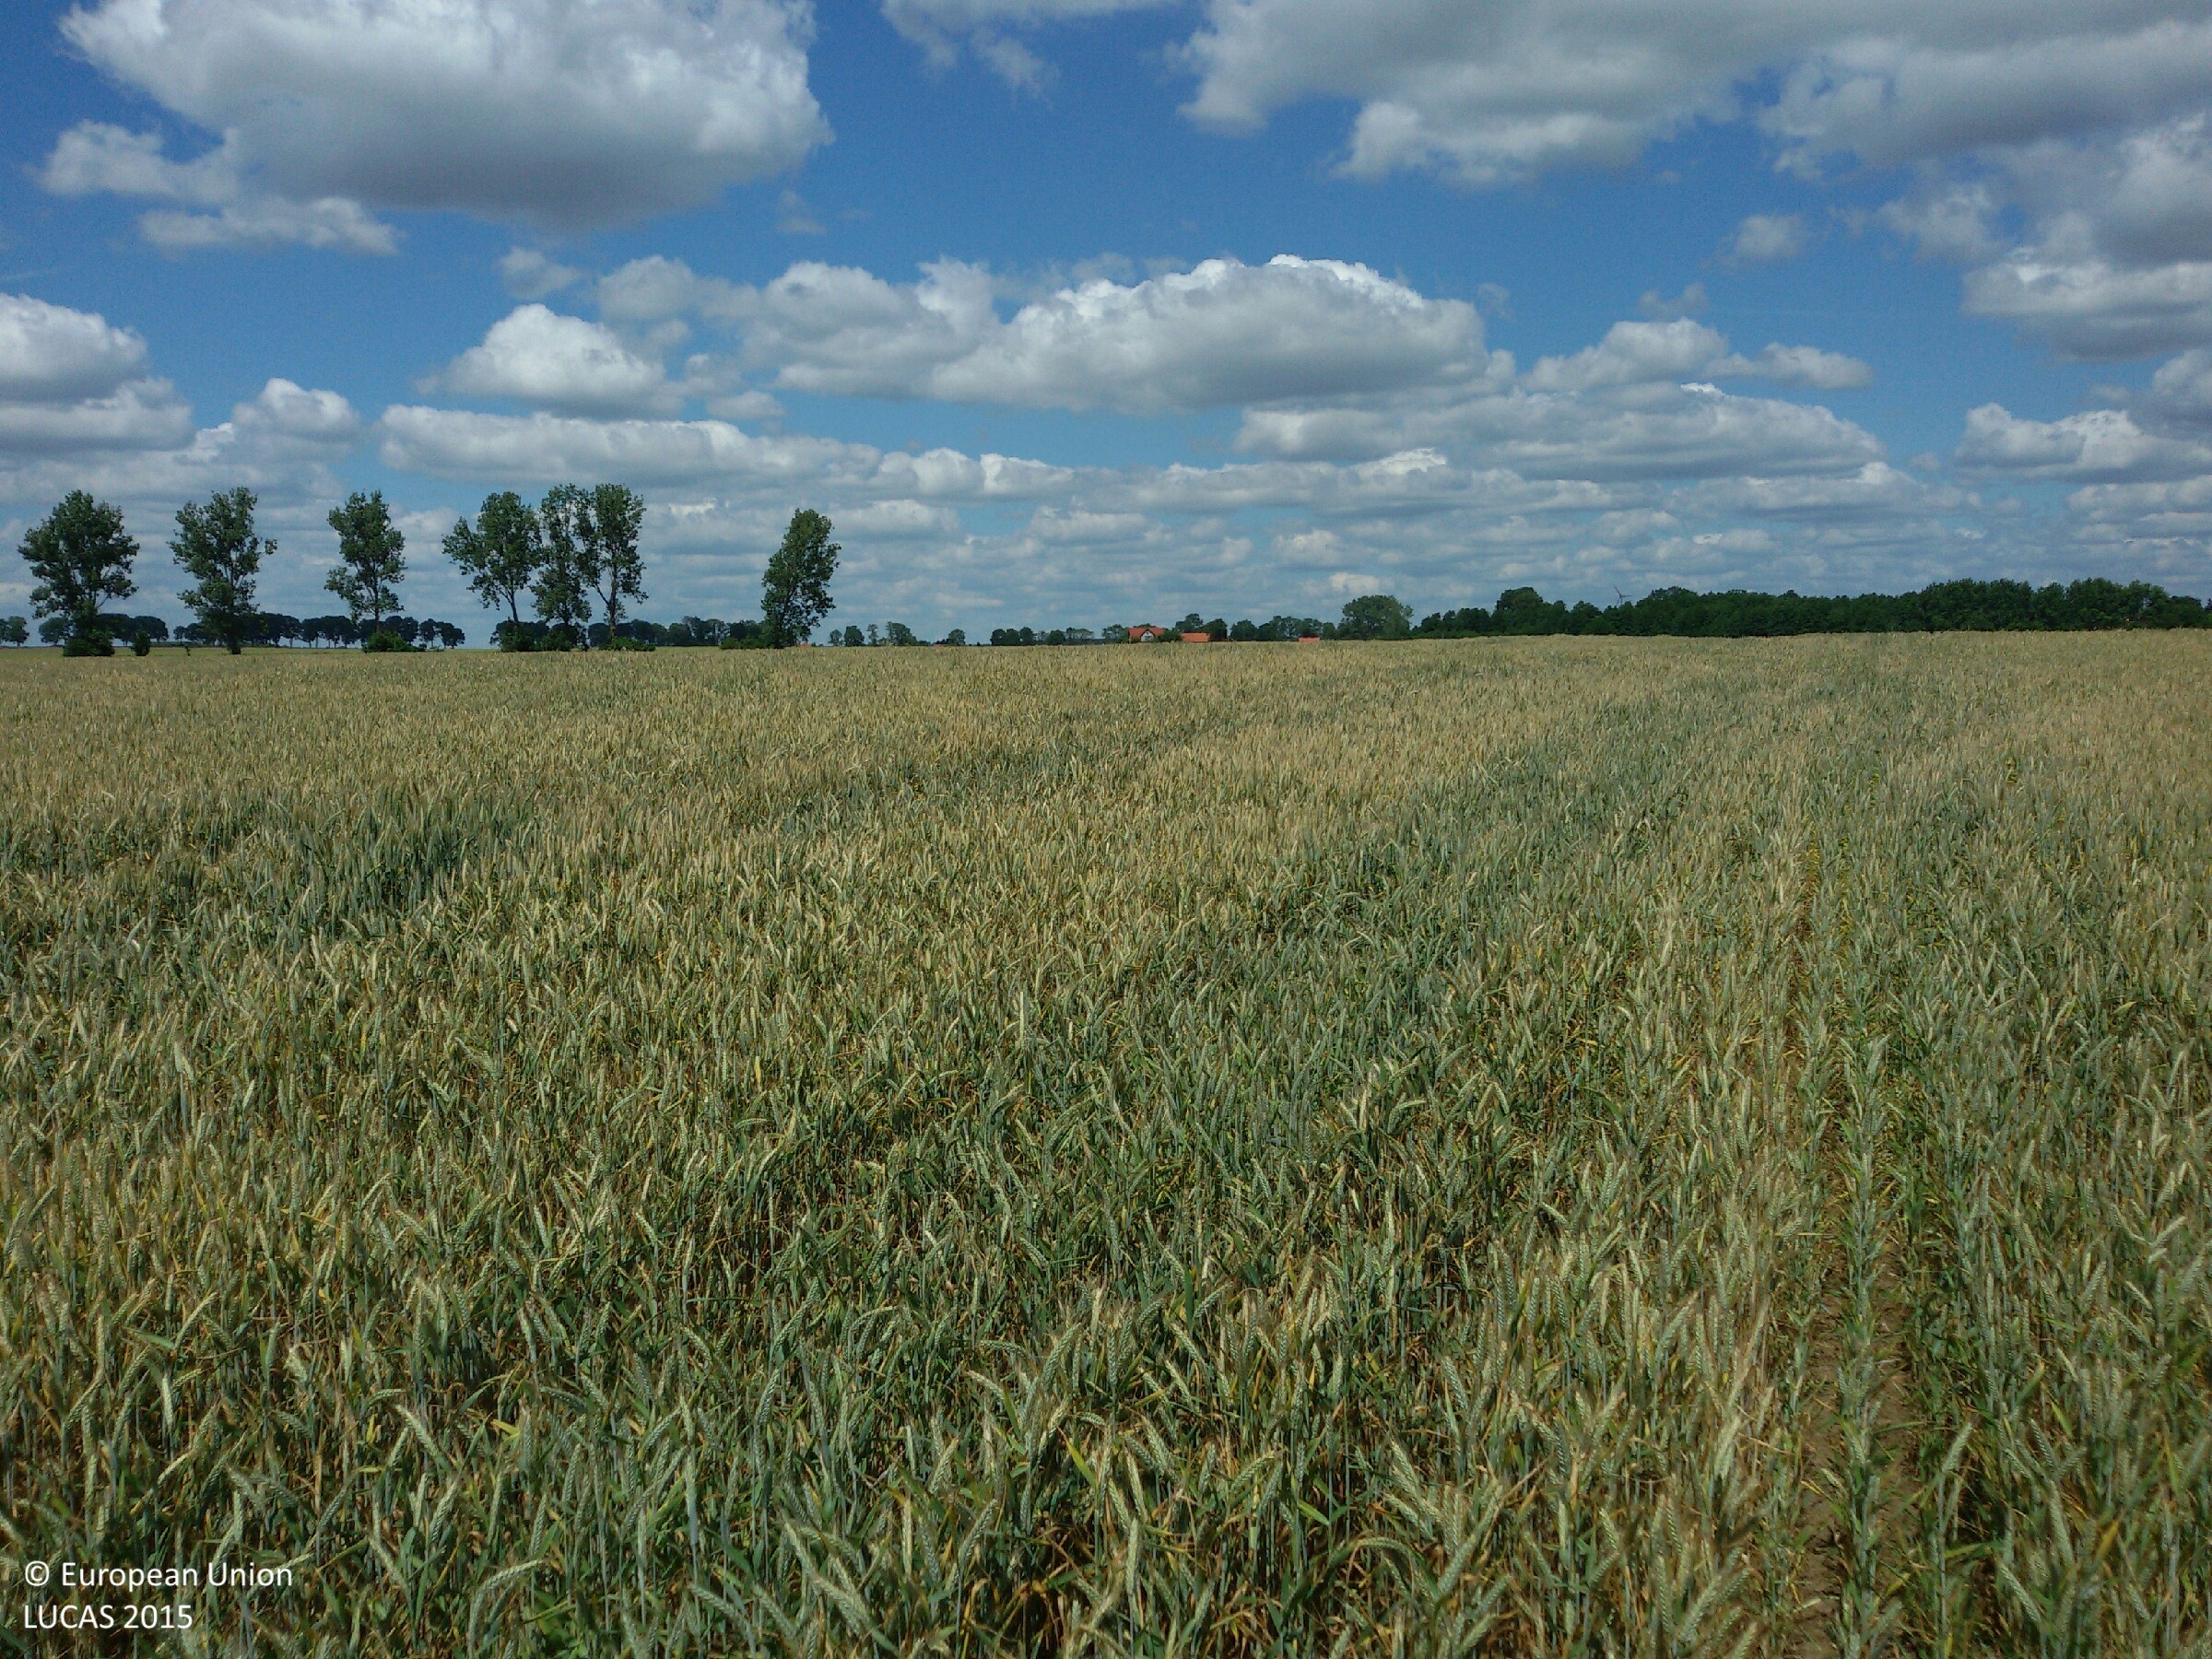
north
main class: Cropland
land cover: Common wheat
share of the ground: > 75 %
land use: Agriculture (excluding fallow land and kitchen gardens)
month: July
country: PL
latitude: 53.3757
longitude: 20.1192
